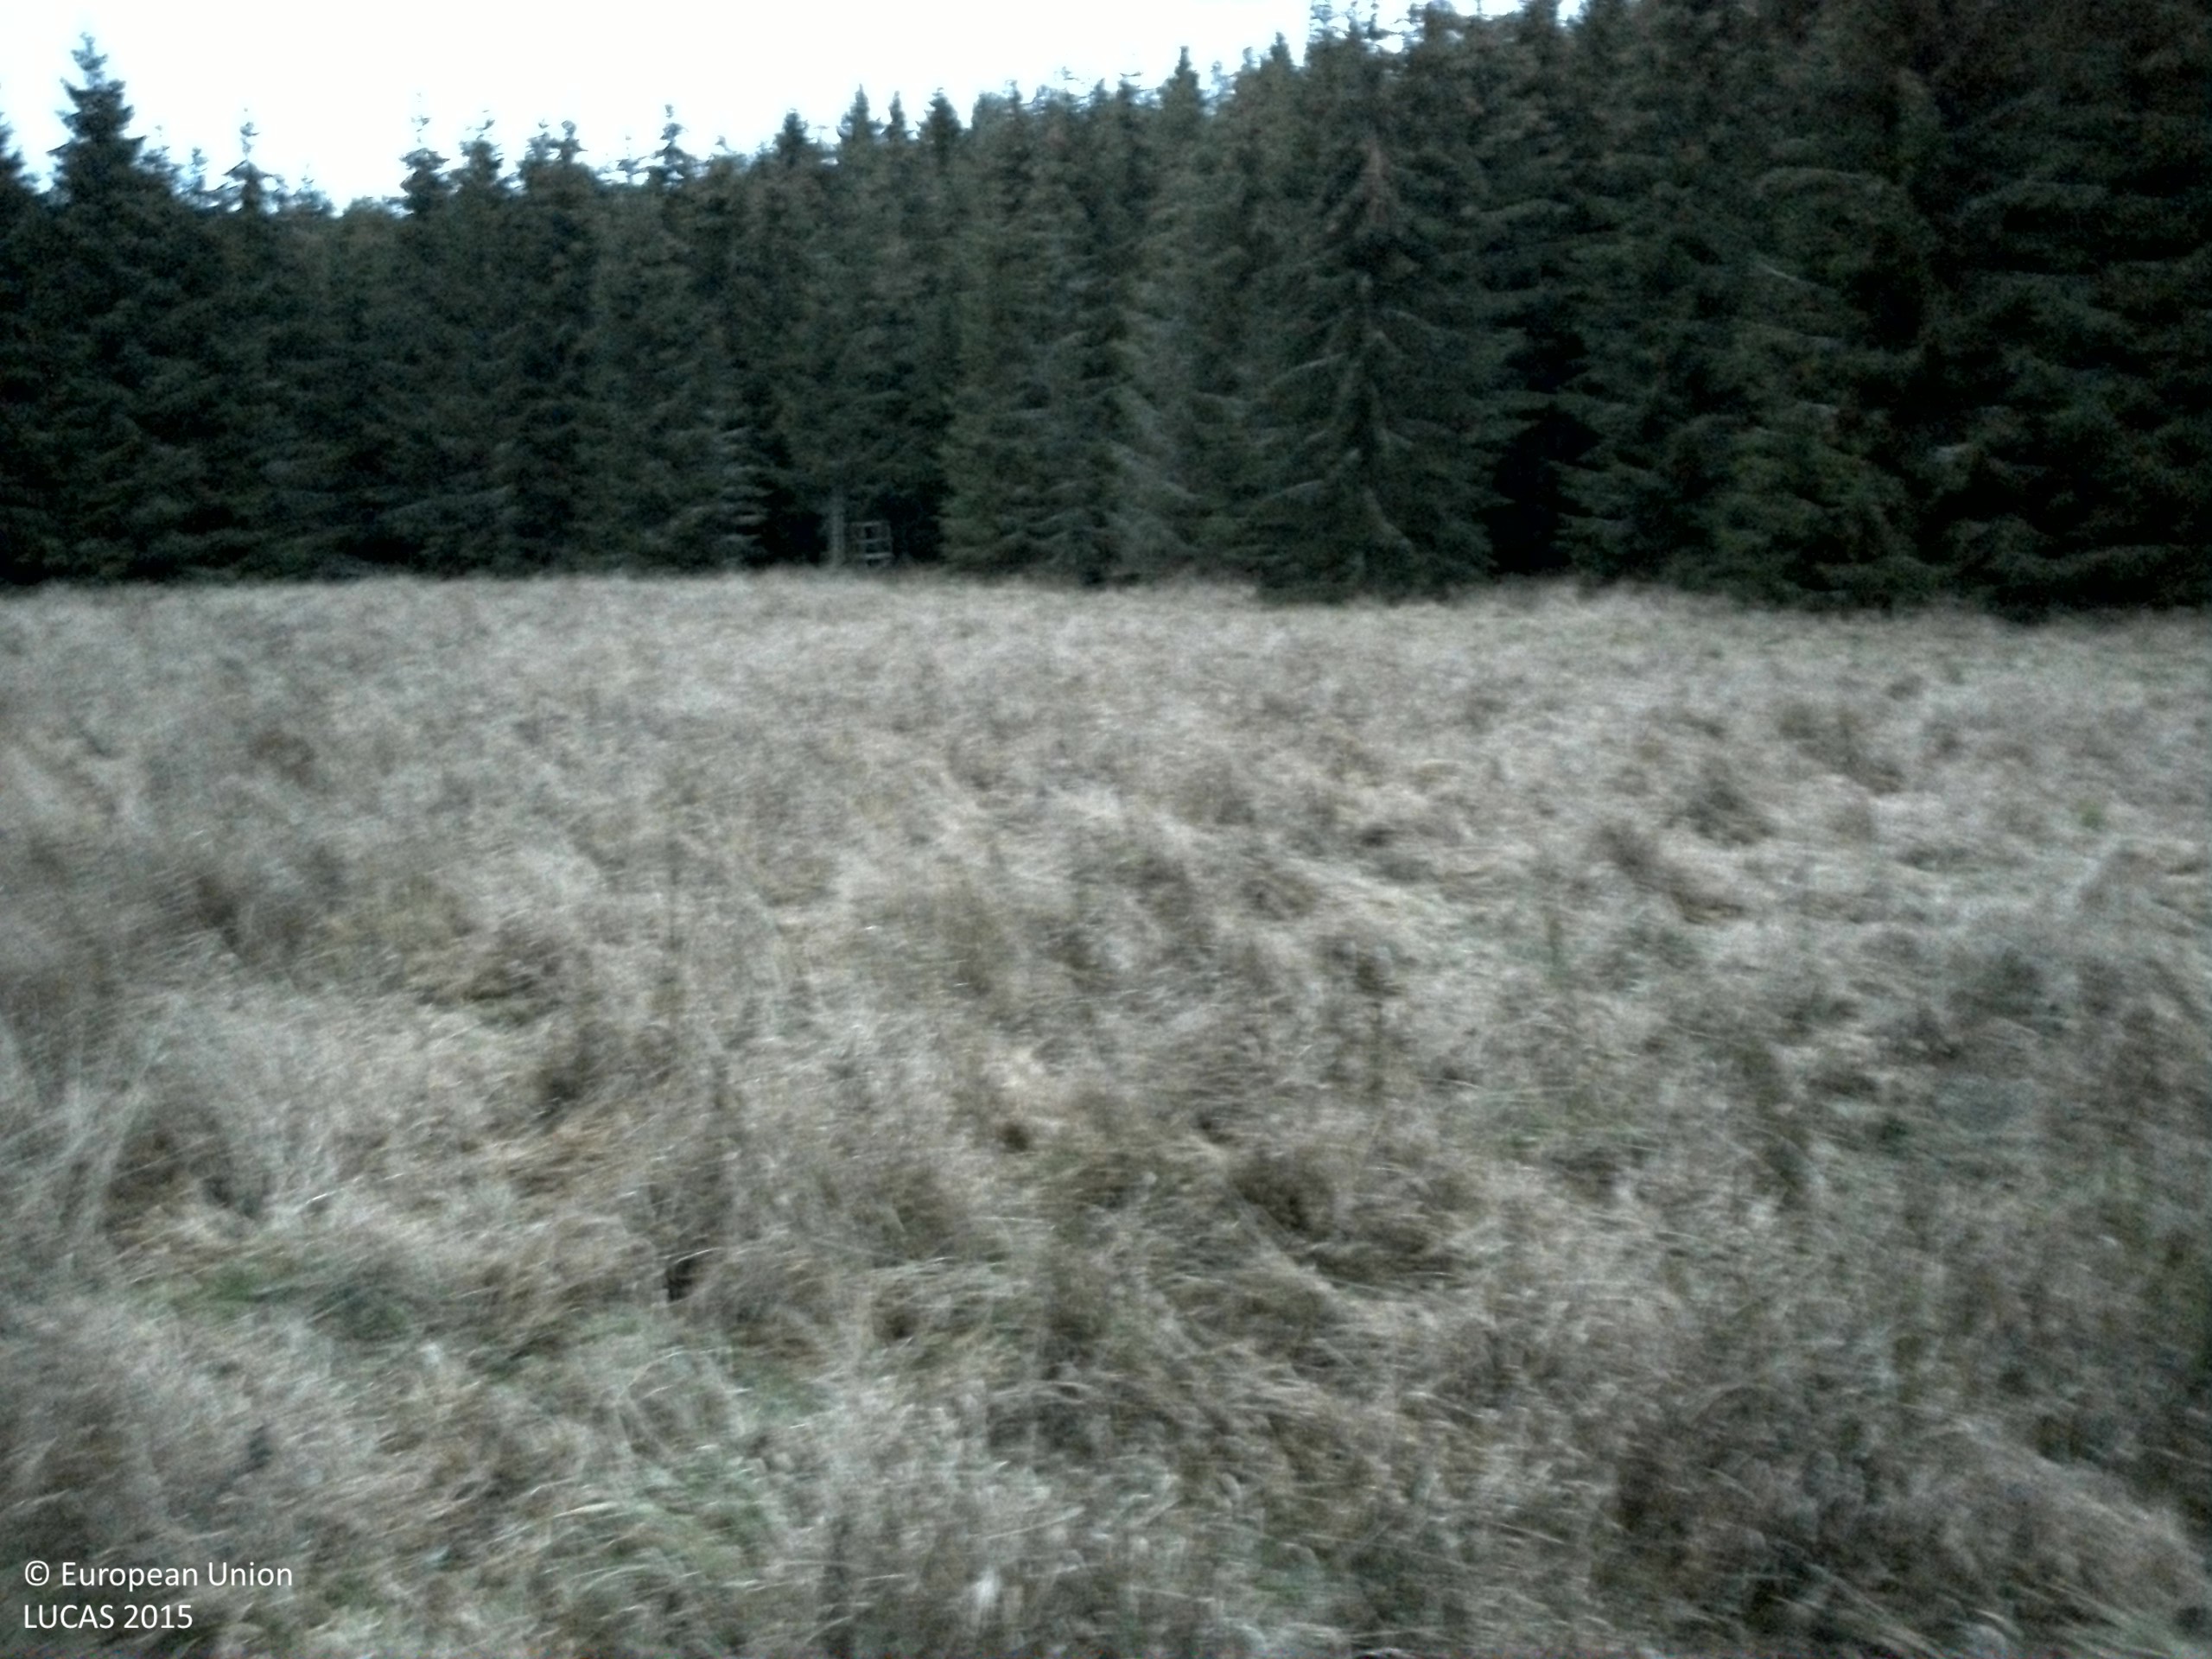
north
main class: Grassland
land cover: Grassland without tree/shrub cover
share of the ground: > 75 %
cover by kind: herbaceous plants 95 %, consolidated bare surface 5 %
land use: Other primary production
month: November
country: SE
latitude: 58.8222
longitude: 16.8366
